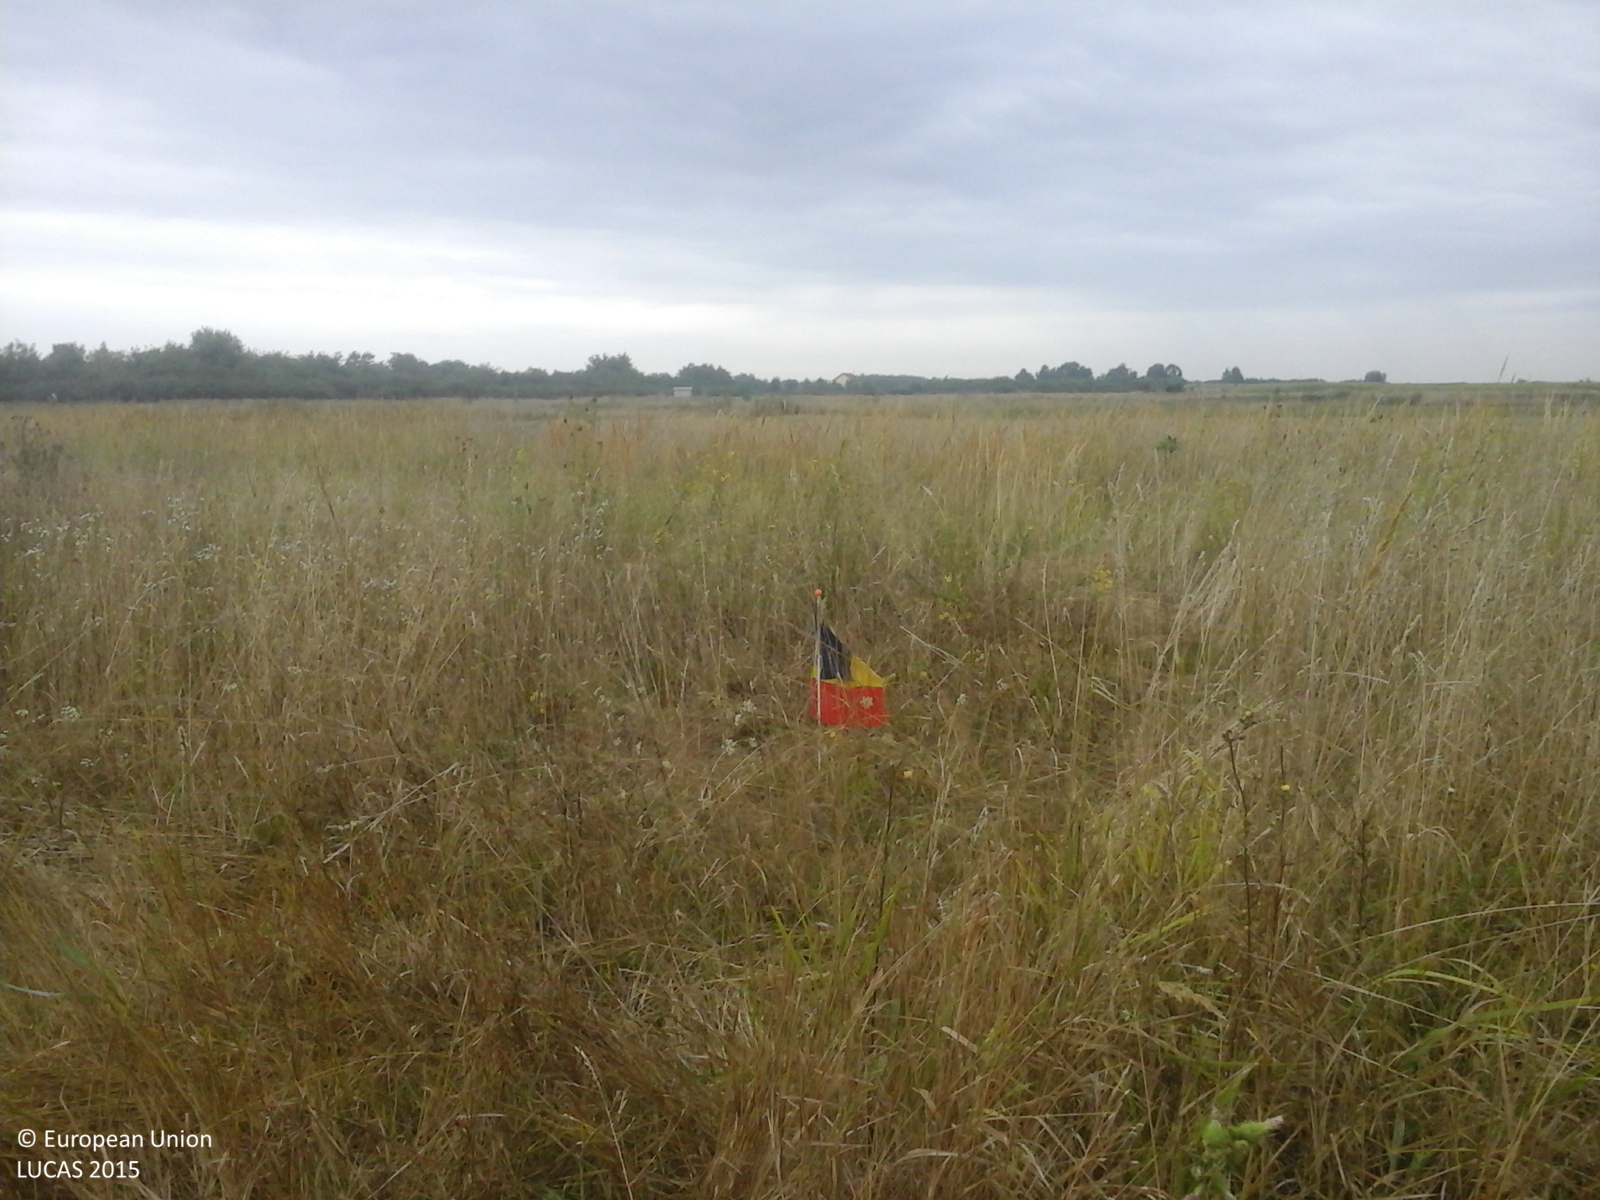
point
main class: Grassland
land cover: Spontaneously vegetated surfaces
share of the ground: > 75 %
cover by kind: herbaceous plants 100 %
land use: Agriculture (excluding fallow land and kitchen gardens)
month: August
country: RO
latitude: 45.4761
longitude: 21.1445
